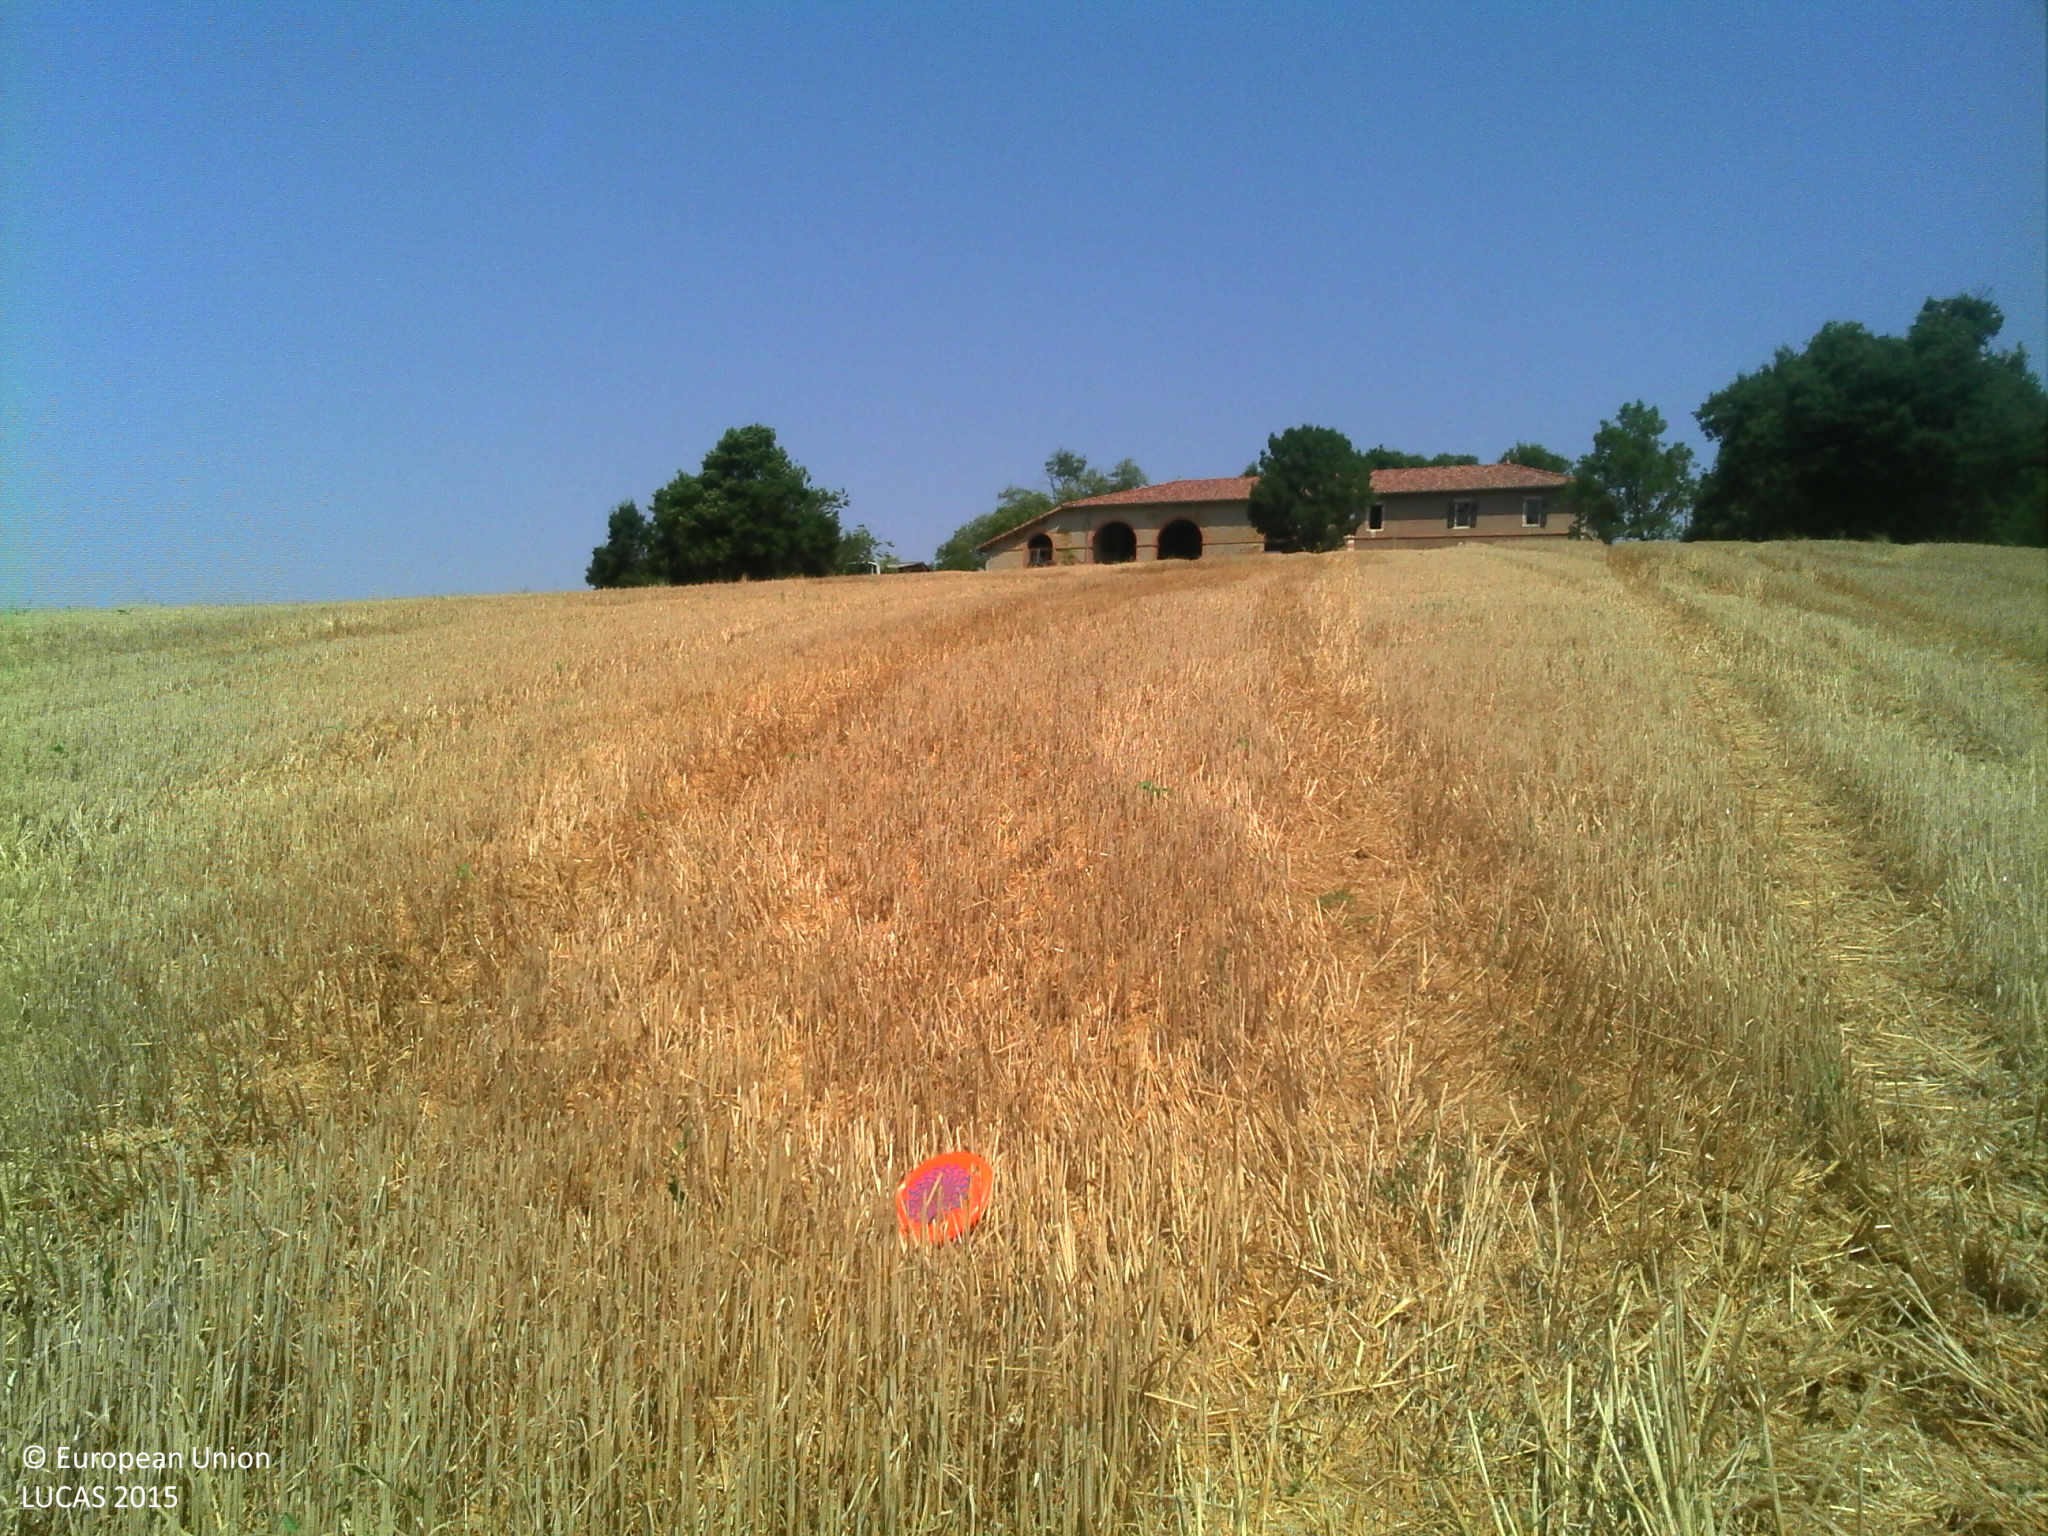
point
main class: Cropland
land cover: Barley
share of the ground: > 75 %
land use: Agriculture (excluding fallow land and kitchen gardens)
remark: Harvested field
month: July
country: FR
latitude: 43.3428
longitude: 1.0094
